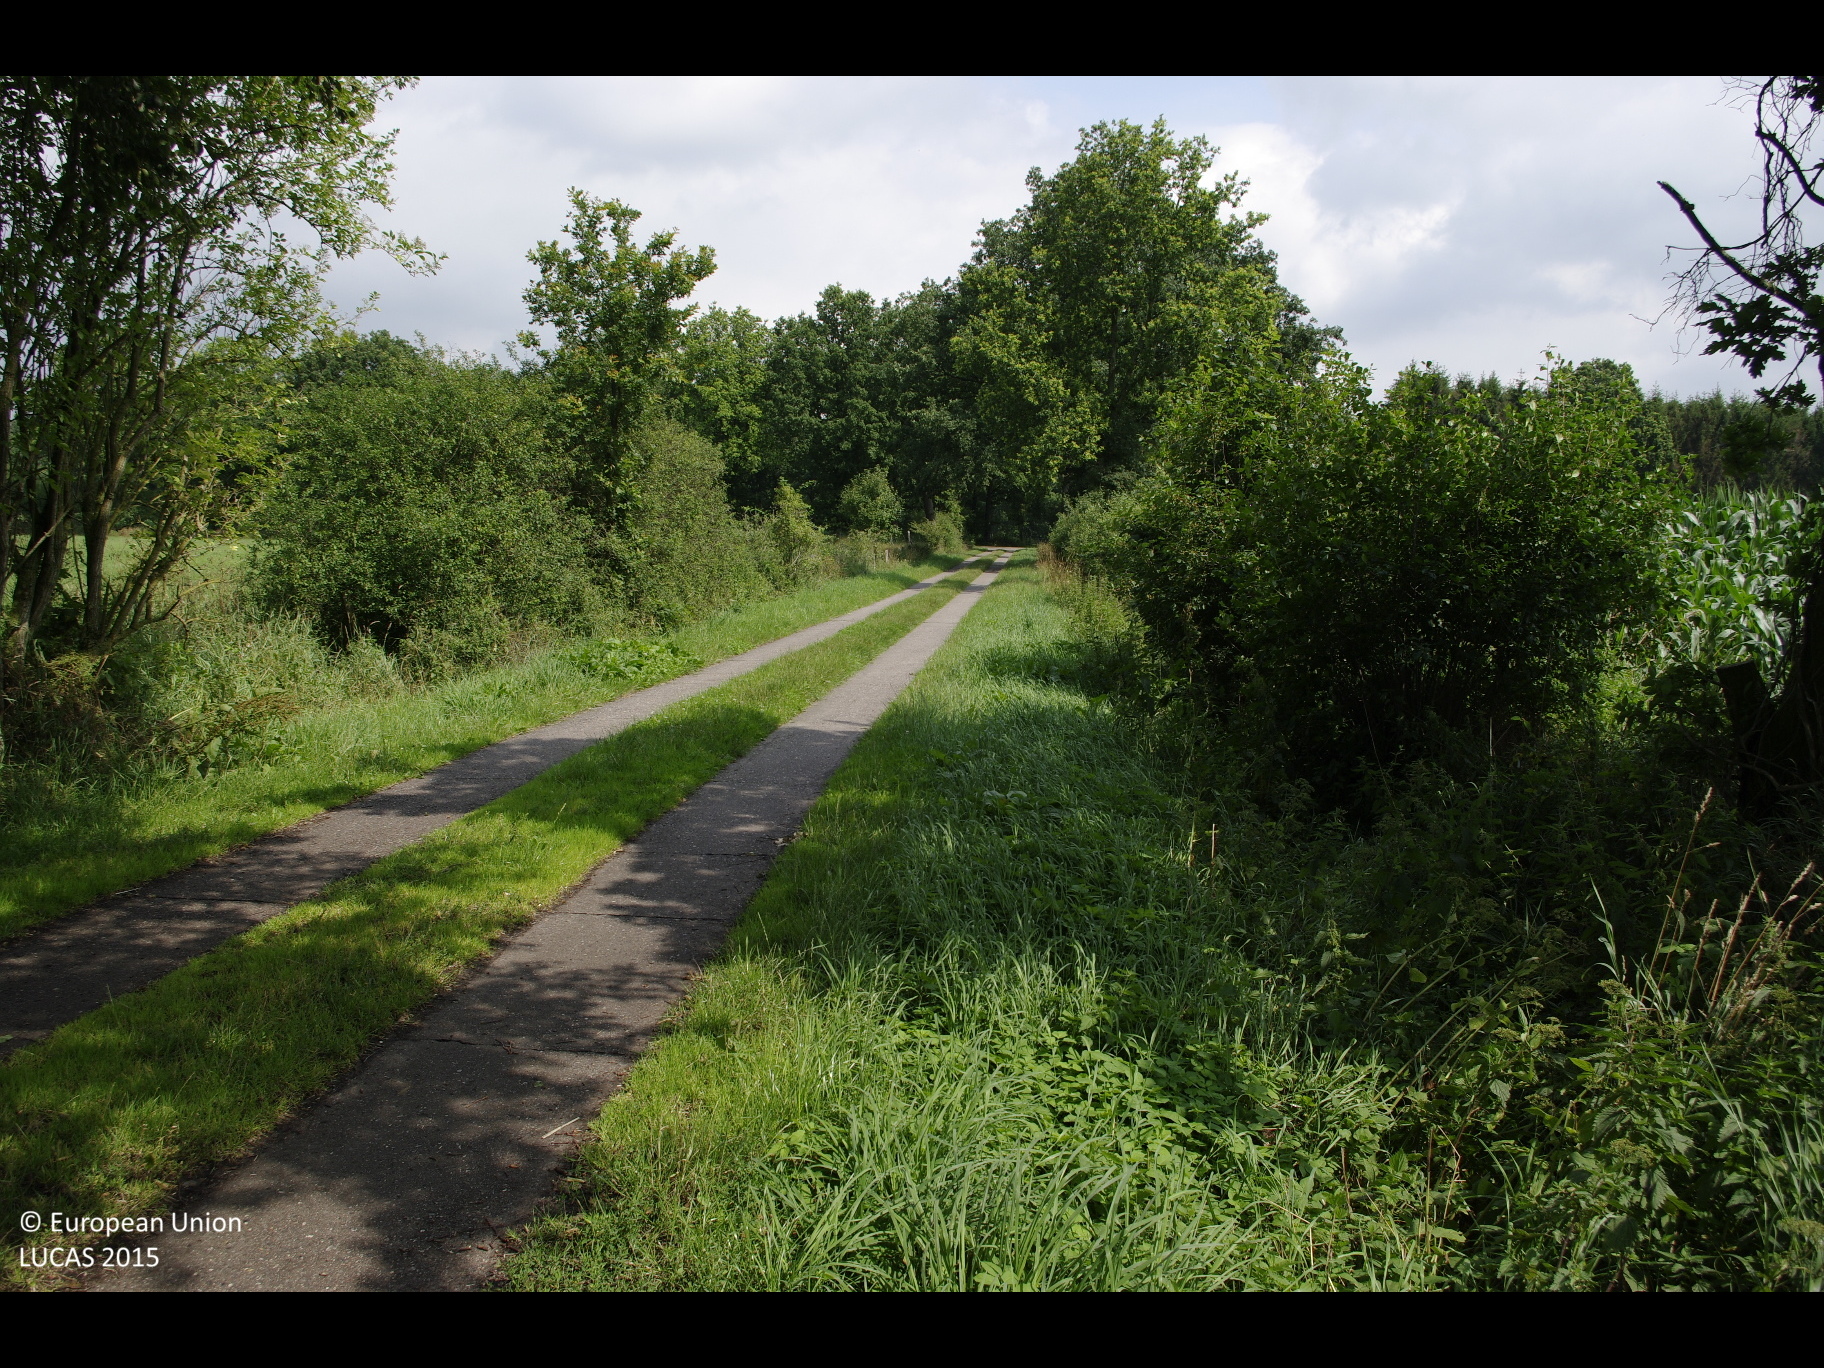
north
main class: Cropland
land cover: Maize
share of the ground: > 75 %
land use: Agriculture (excluding fallow land and kitchen gardens)
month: July
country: DE
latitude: 53.8871
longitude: 9.9544
